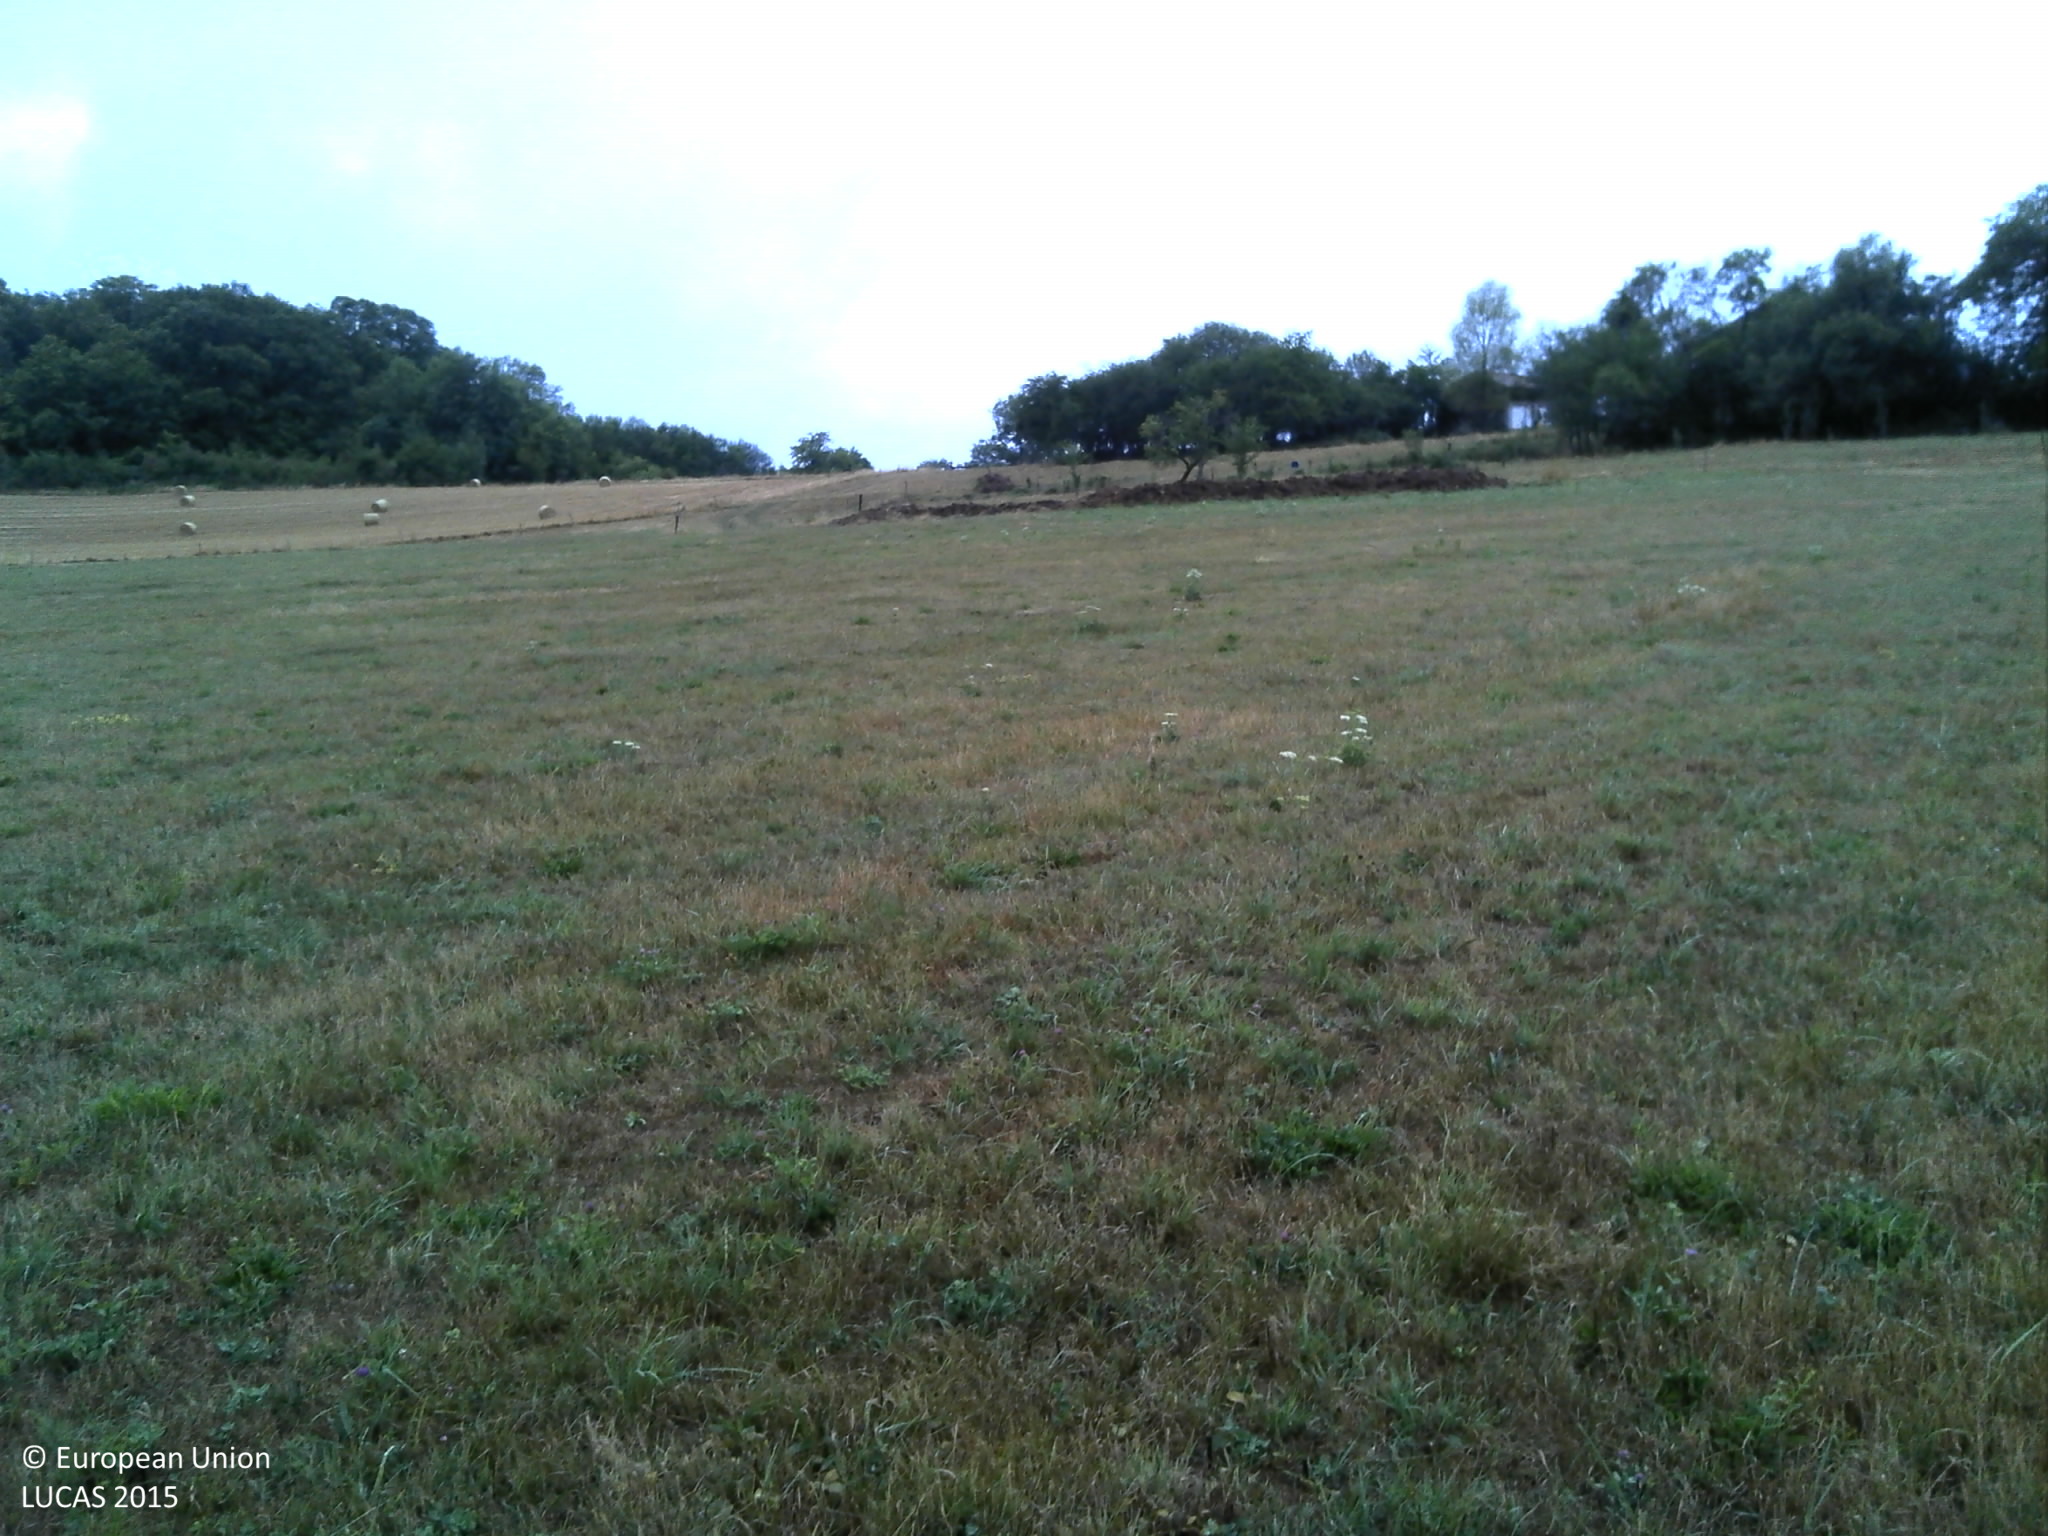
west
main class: Grassland
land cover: Grassland without tree/shrub cover
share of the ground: > 75 %
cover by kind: herbaceous plants 100 %
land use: Agriculture (excluding fallow land and kitchen gardens)
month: July
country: FR
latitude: 47.9423
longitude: 6.2121
